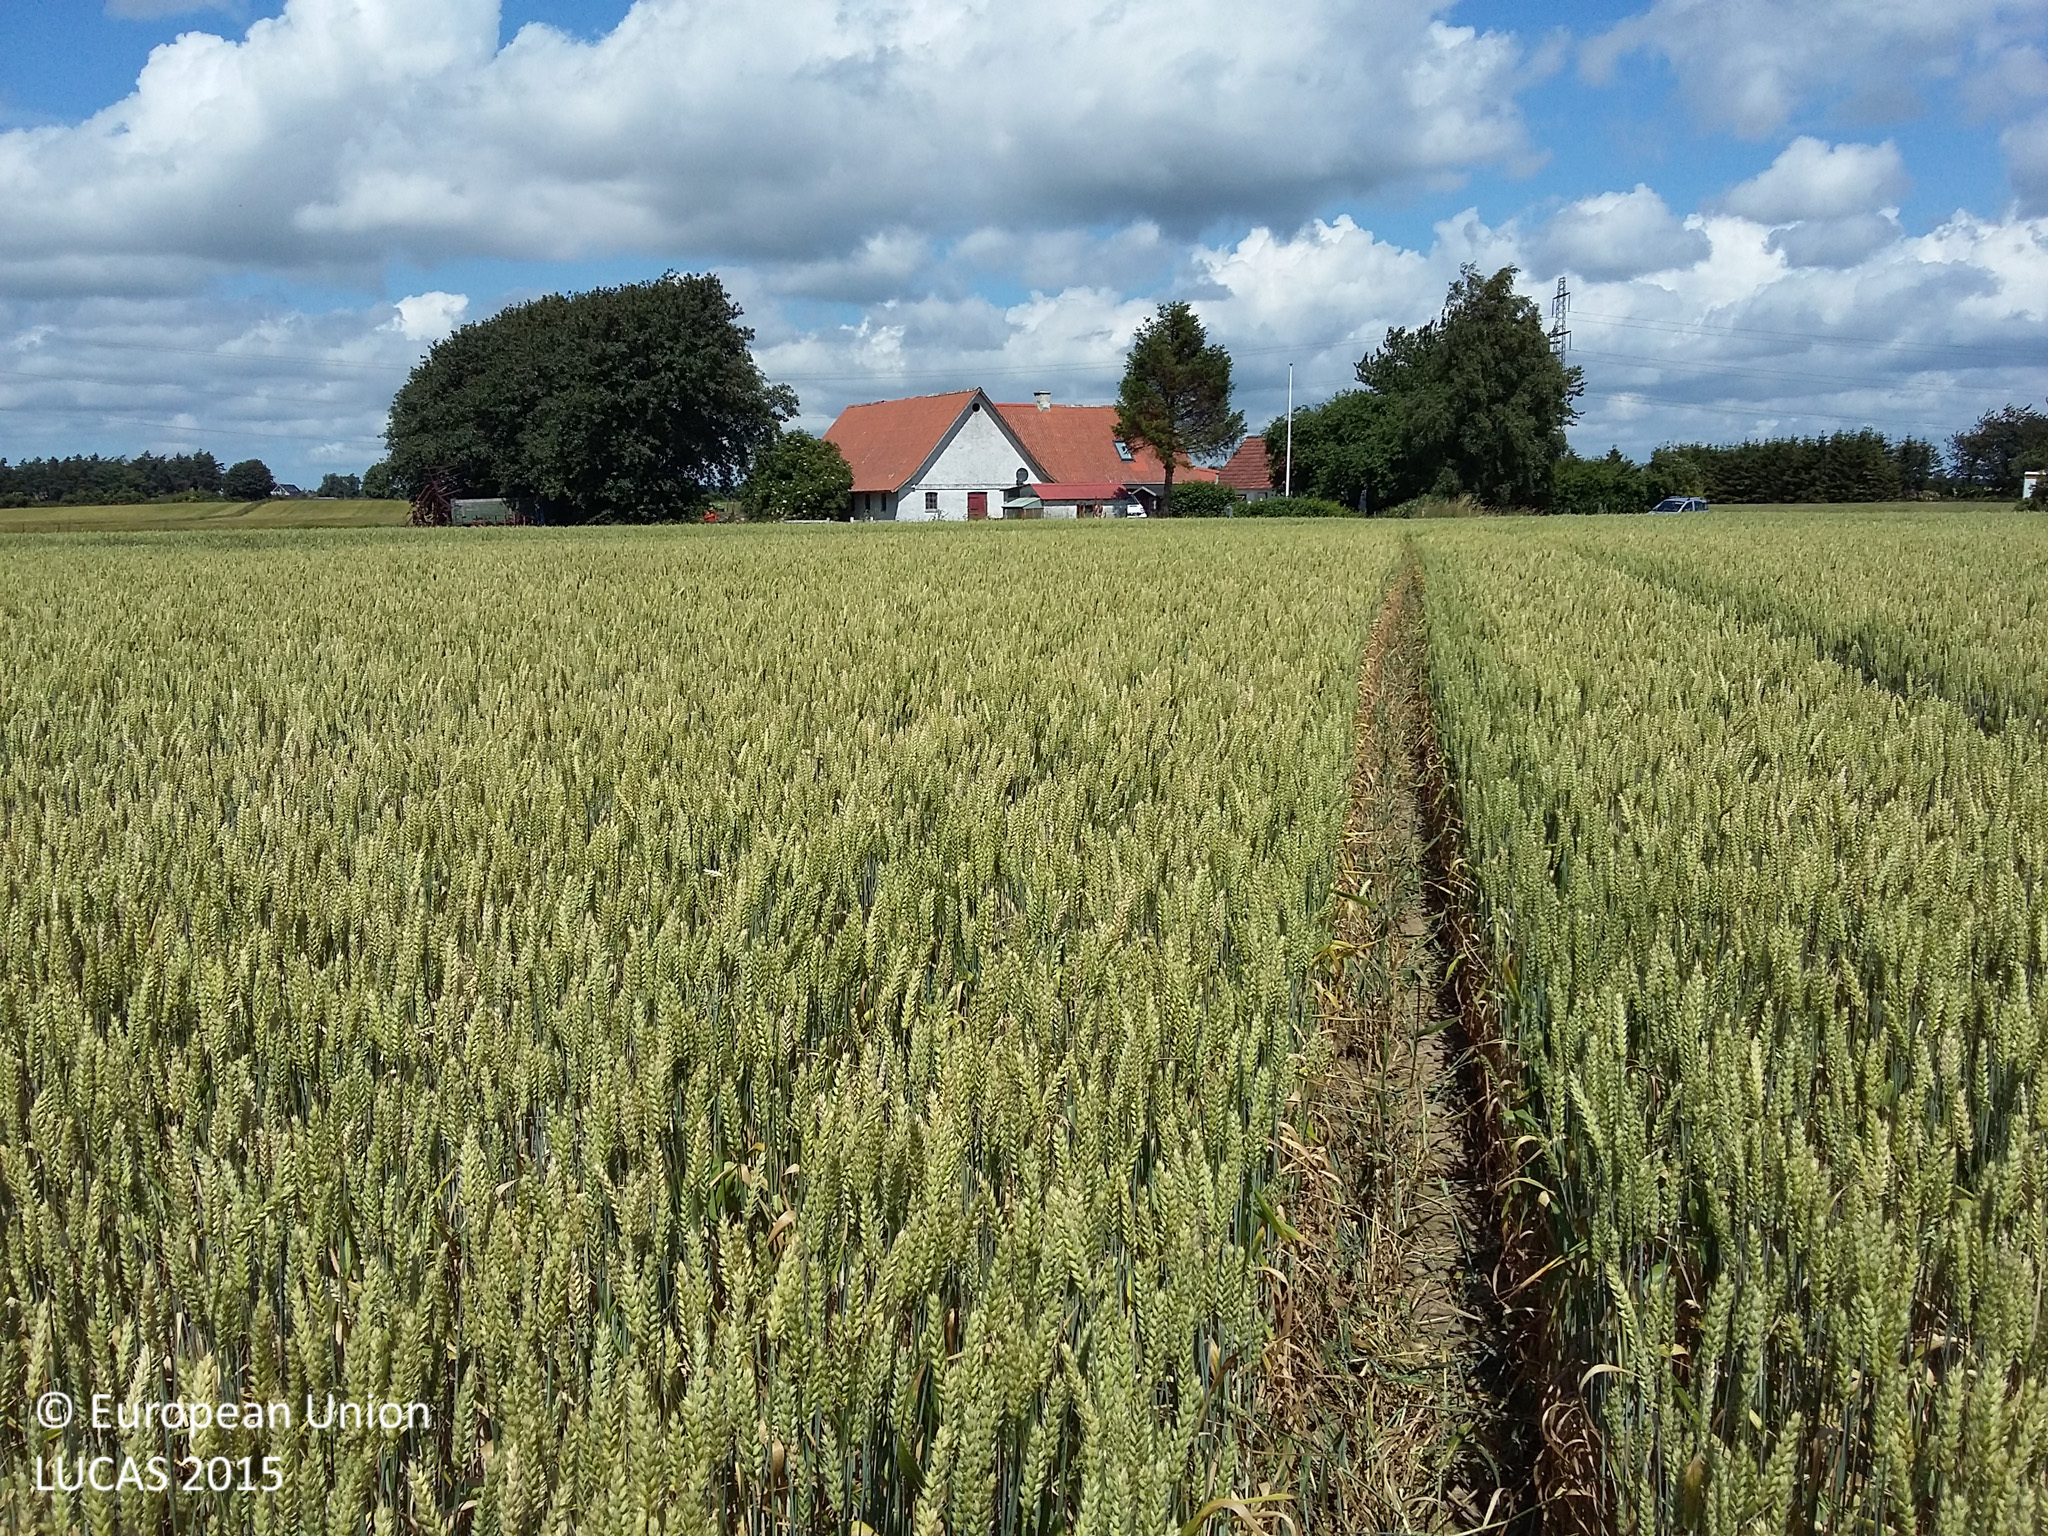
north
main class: Cropland
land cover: Common wheat
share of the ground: > 75 %
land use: Agriculture (excluding fallow land and kitchen gardens)
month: July
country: DK
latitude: 55.5138
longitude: 11.5031
